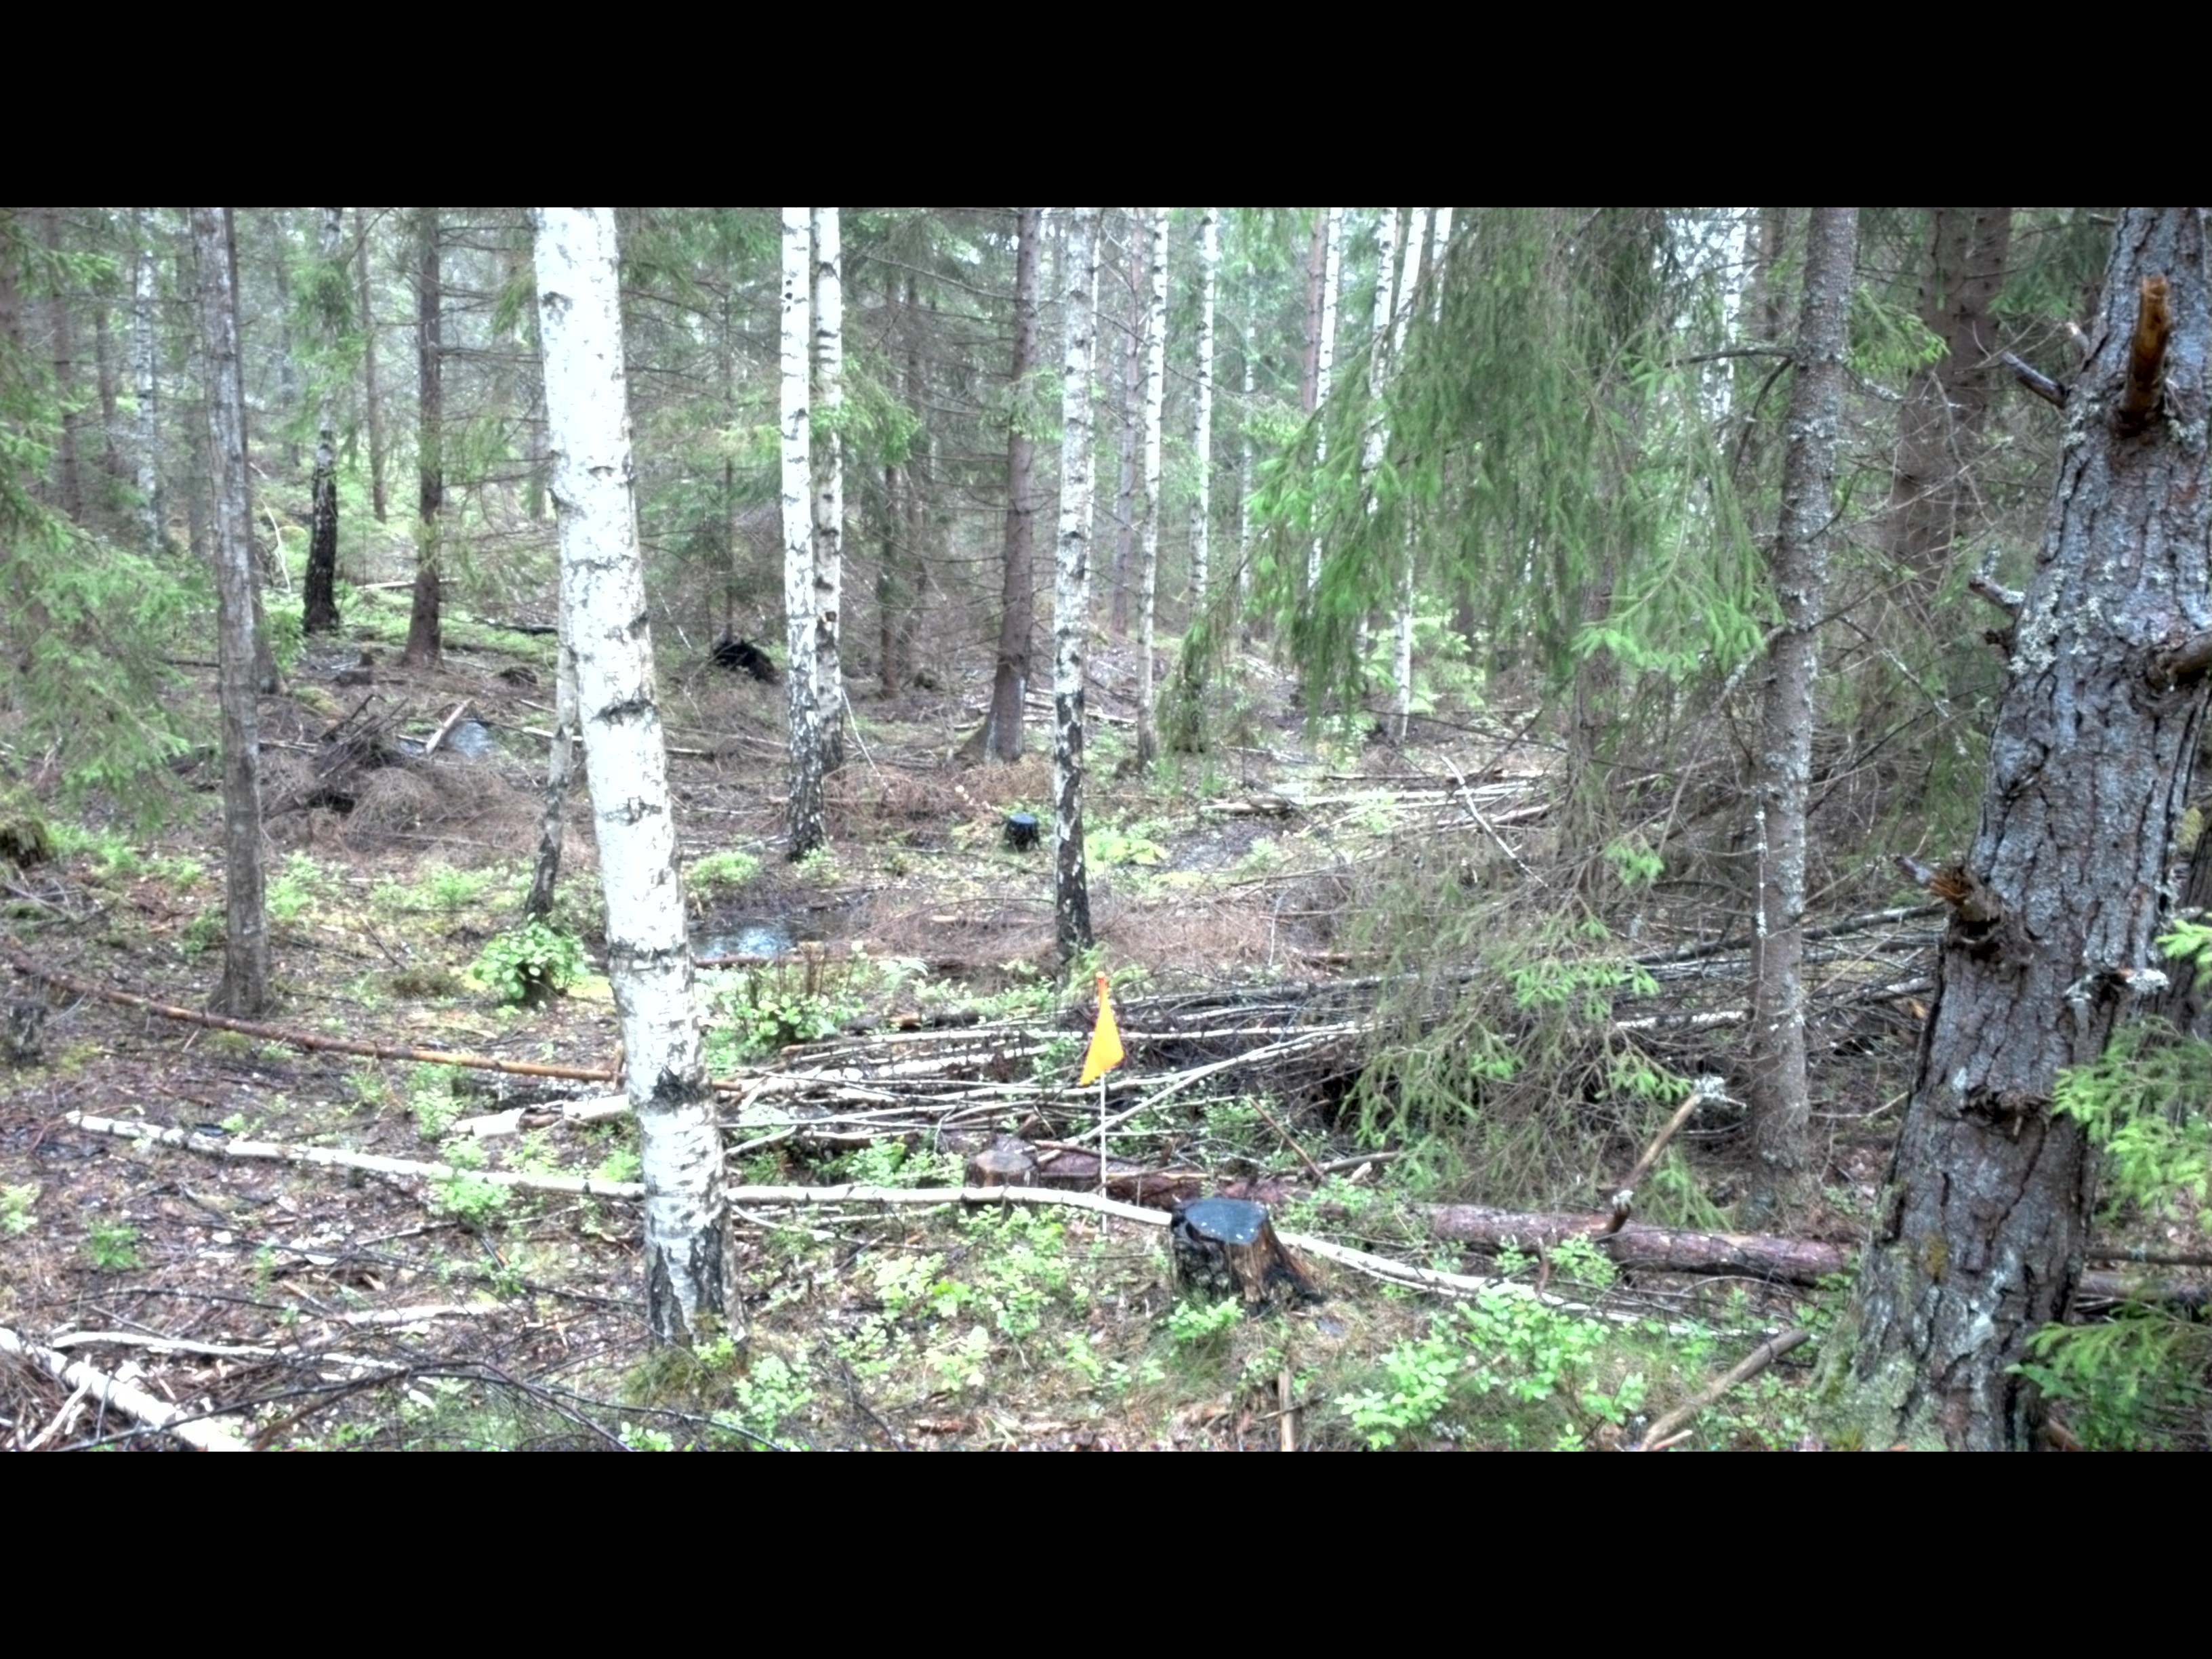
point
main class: Woodland
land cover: Spruce dominated mixed woodland
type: boreal forest
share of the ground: 50 - 75 %
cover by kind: coniferous forest trees 35 %, broadleaved forest trees 30 %, shrubs 15 %, lichens and mosses 10 %, unconsolidated bare surface 10 %
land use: Forestry
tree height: > 5 m
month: June
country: SE
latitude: 57.9635
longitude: 16.3017
